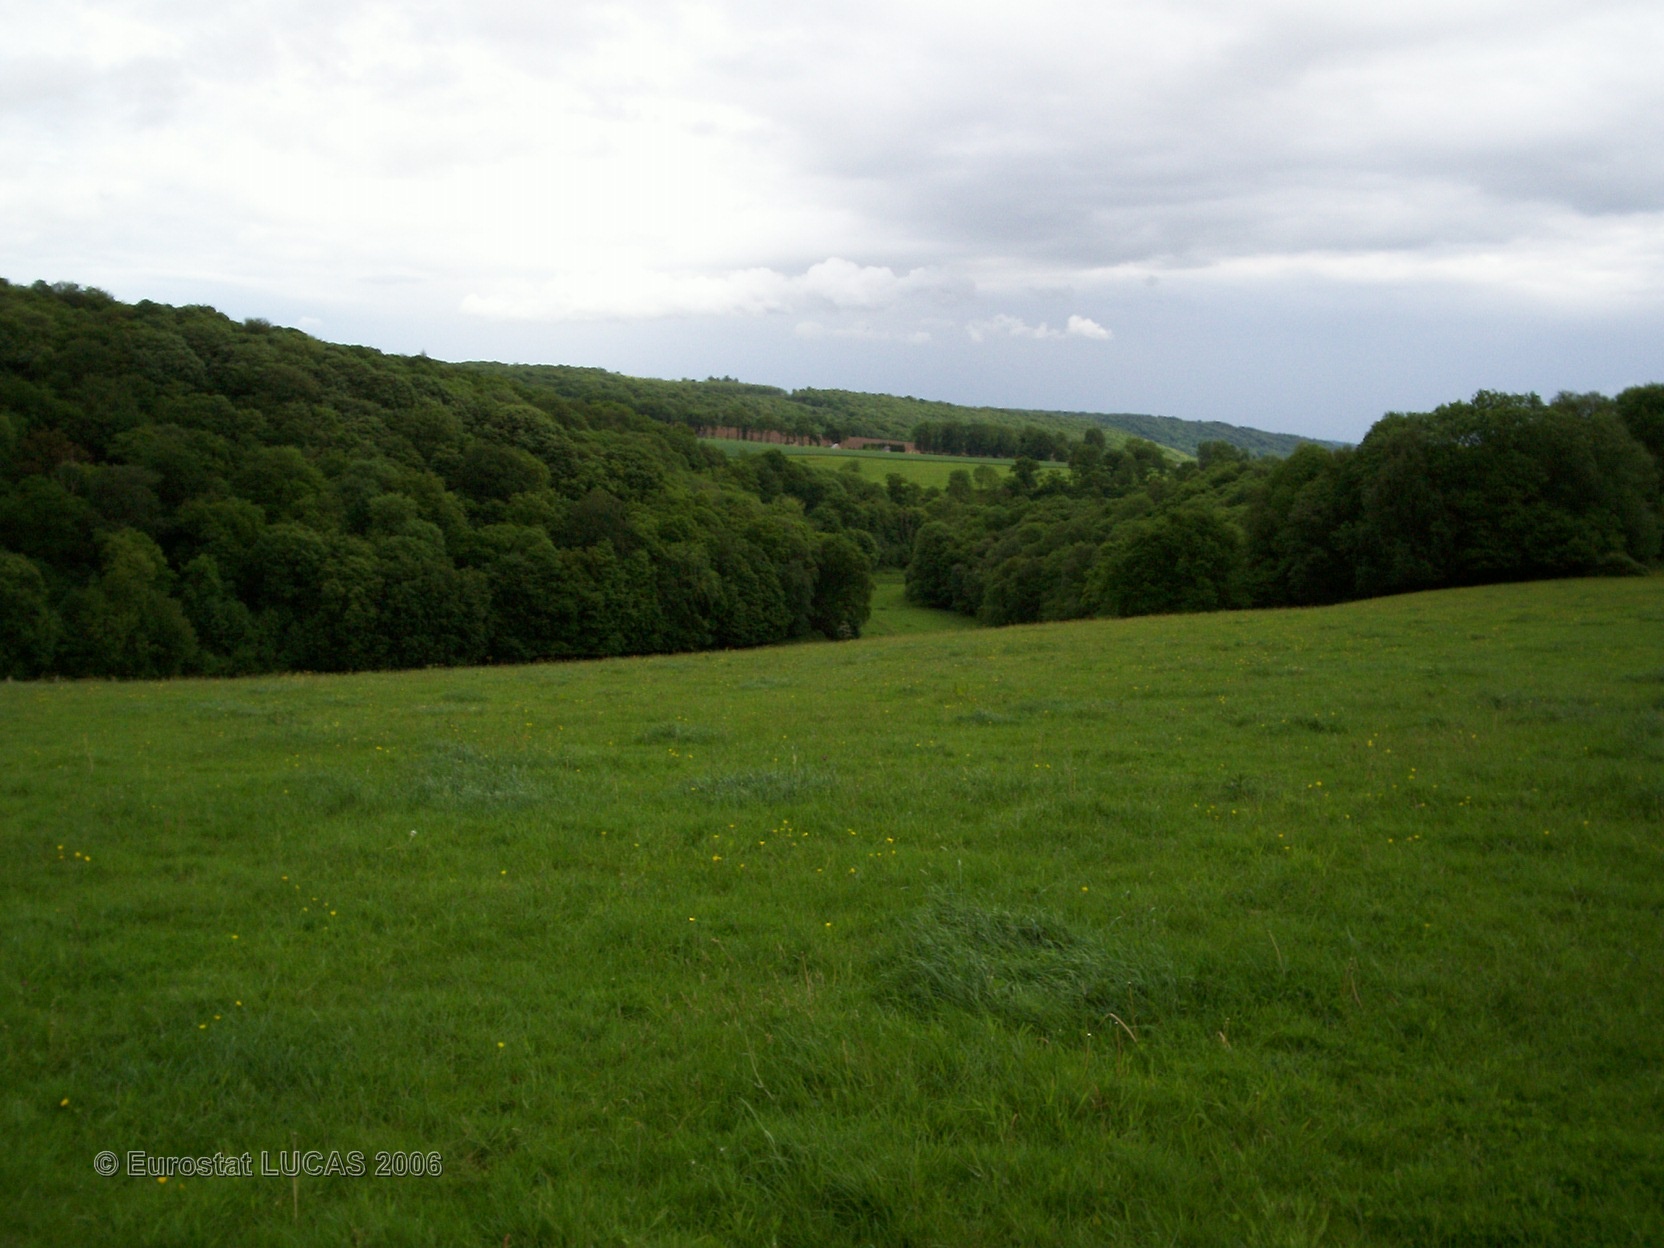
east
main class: Grassland
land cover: Grassland without tree/shrub cover
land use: Agriculture (excluding fallow land and kitchen gardens)
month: May
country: FR
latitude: 49.5138
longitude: 0.4844
